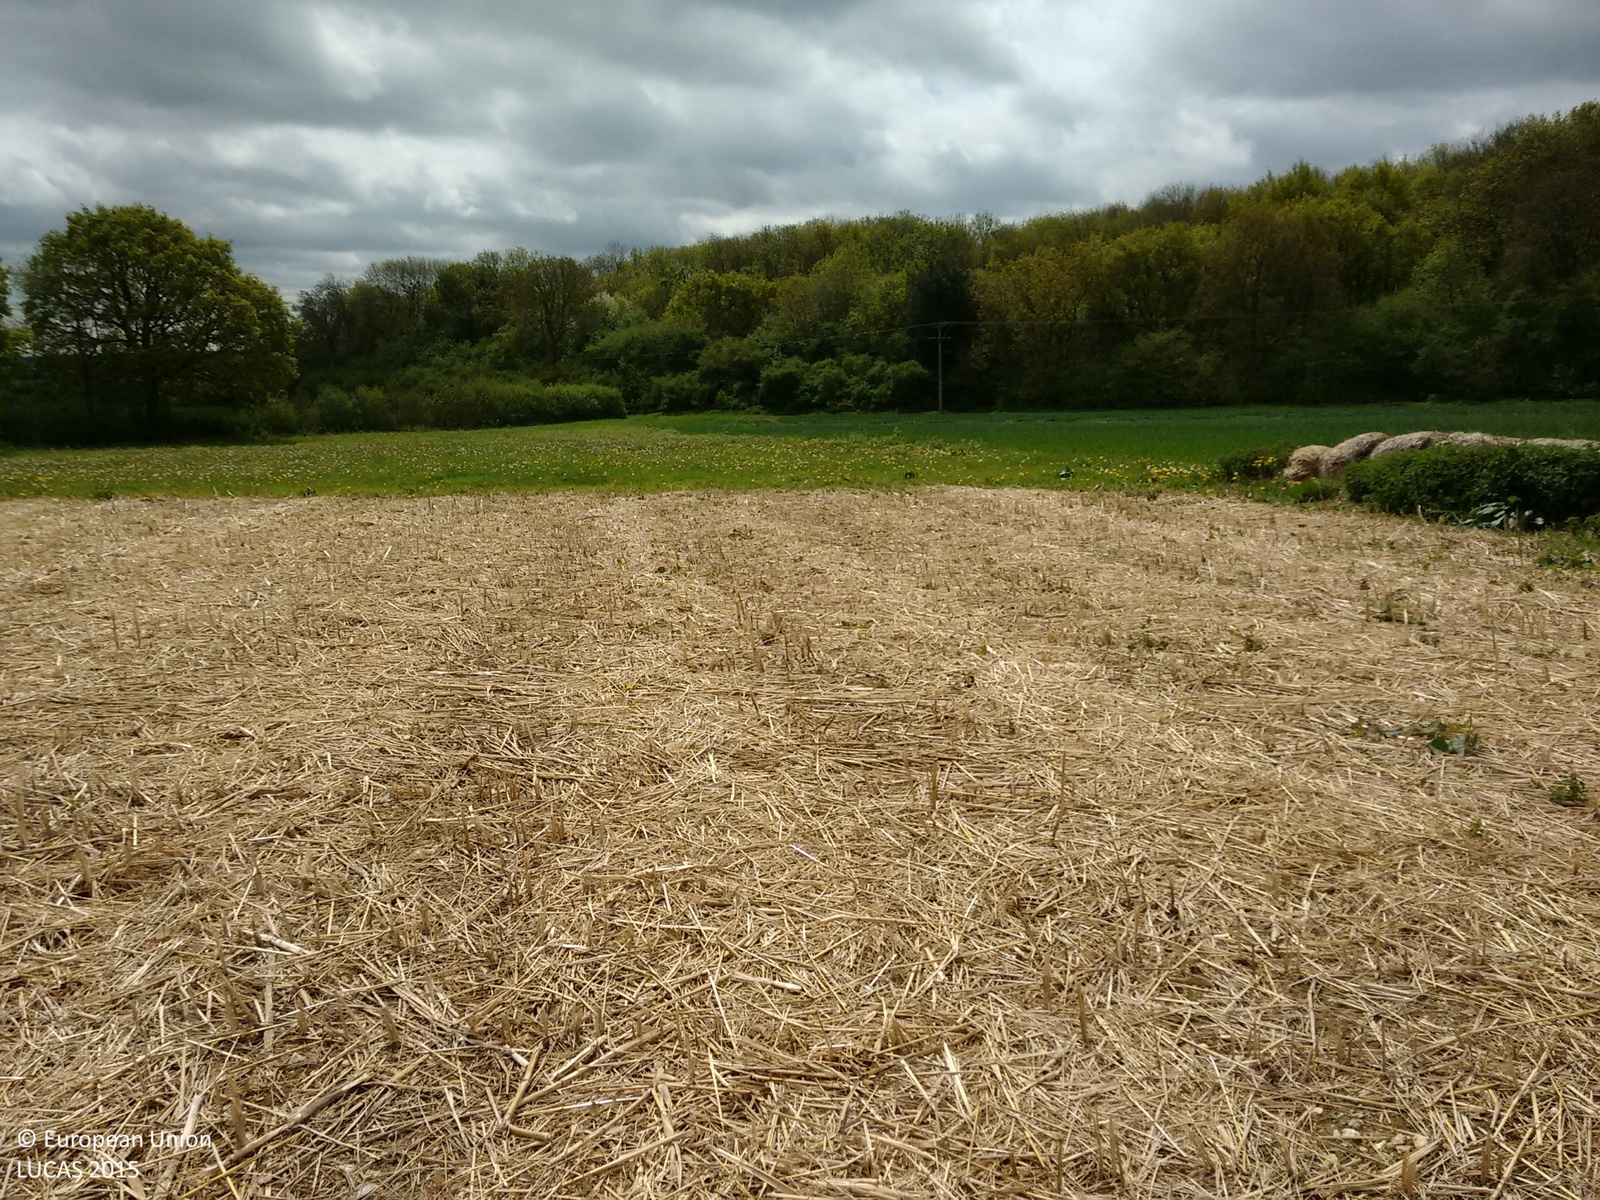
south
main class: Grassland
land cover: Spontaneously vegetated surfaces
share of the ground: < 10 %
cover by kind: unconsolidated bare surface 80 %, herbaceous plants 20 %
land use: Fallow land
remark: Harvested field
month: May
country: GB
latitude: 51.8758
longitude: -0.4820
